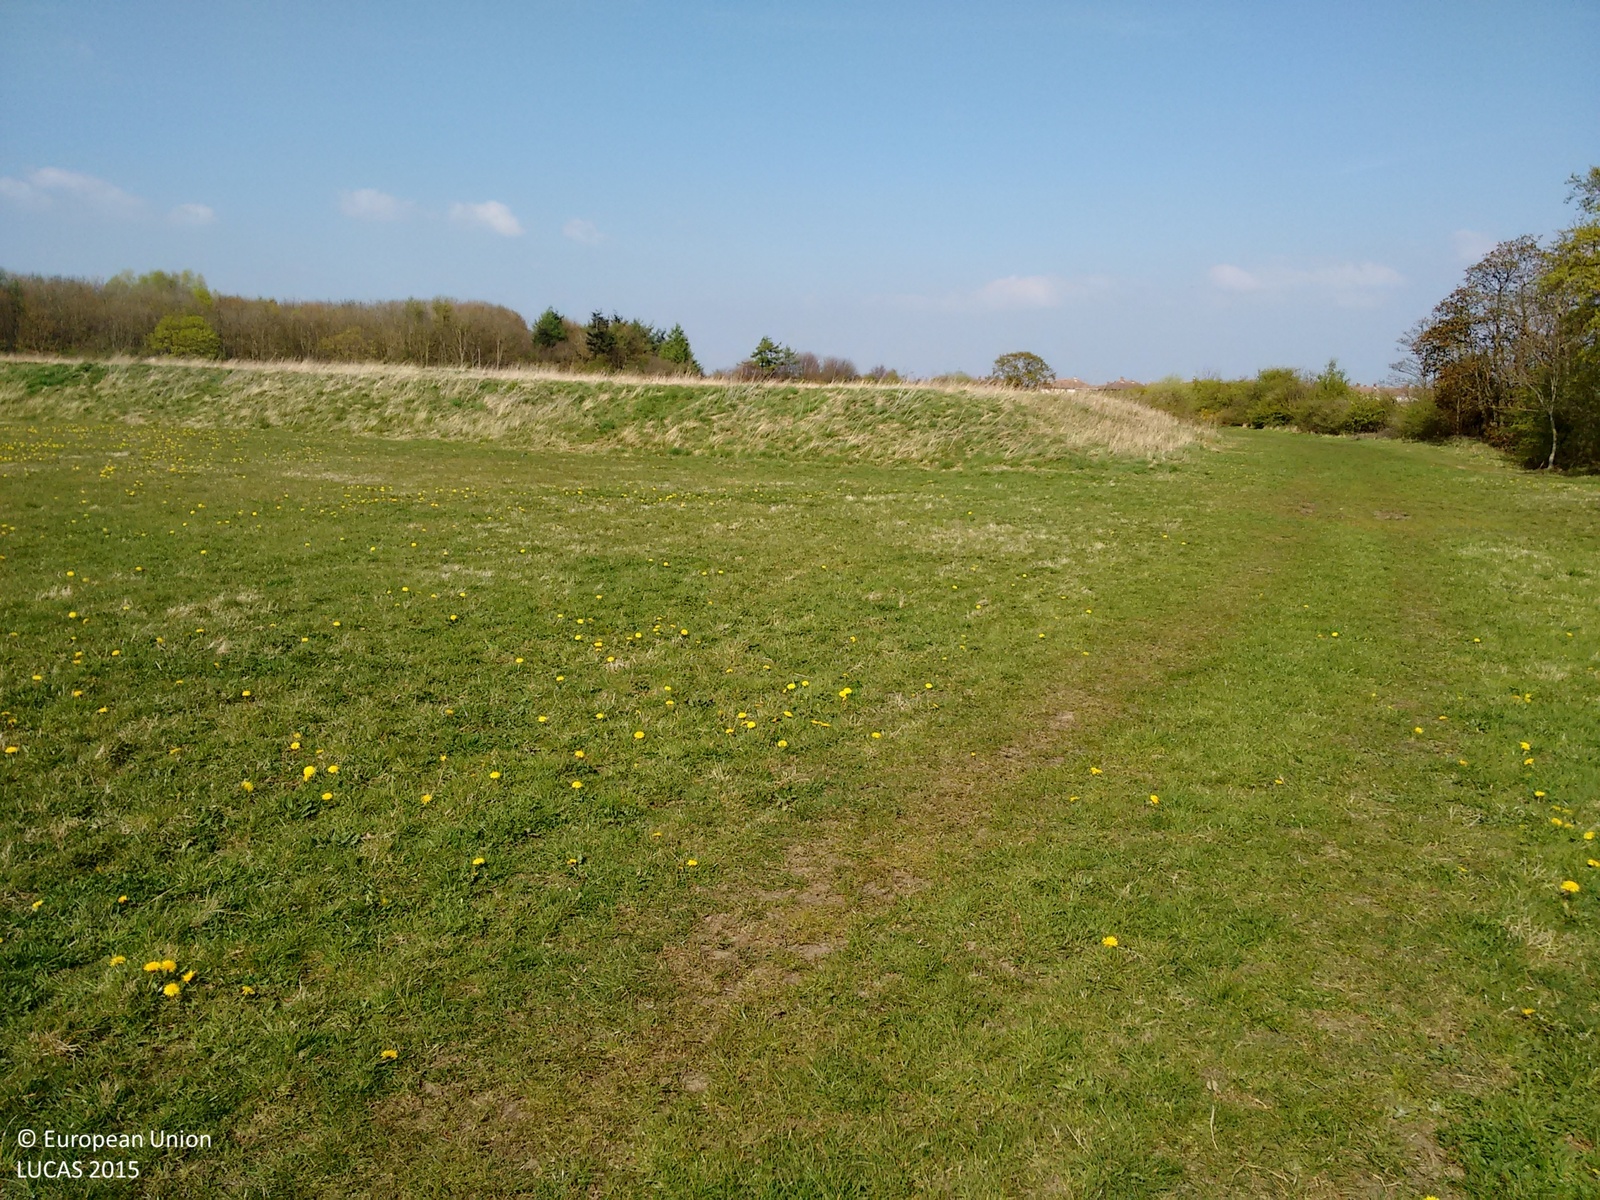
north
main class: Grassland
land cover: Grassland with sparse tree/shrub cover
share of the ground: > 75 %
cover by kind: herbaceous plants 95 %, broadleaved forest trees 5 %
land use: Agriculture (excluding fallow land and kitchen gardens)
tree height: > 5 m
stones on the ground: < 10 %
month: April
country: GB
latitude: 55.0373
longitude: -1.6440
